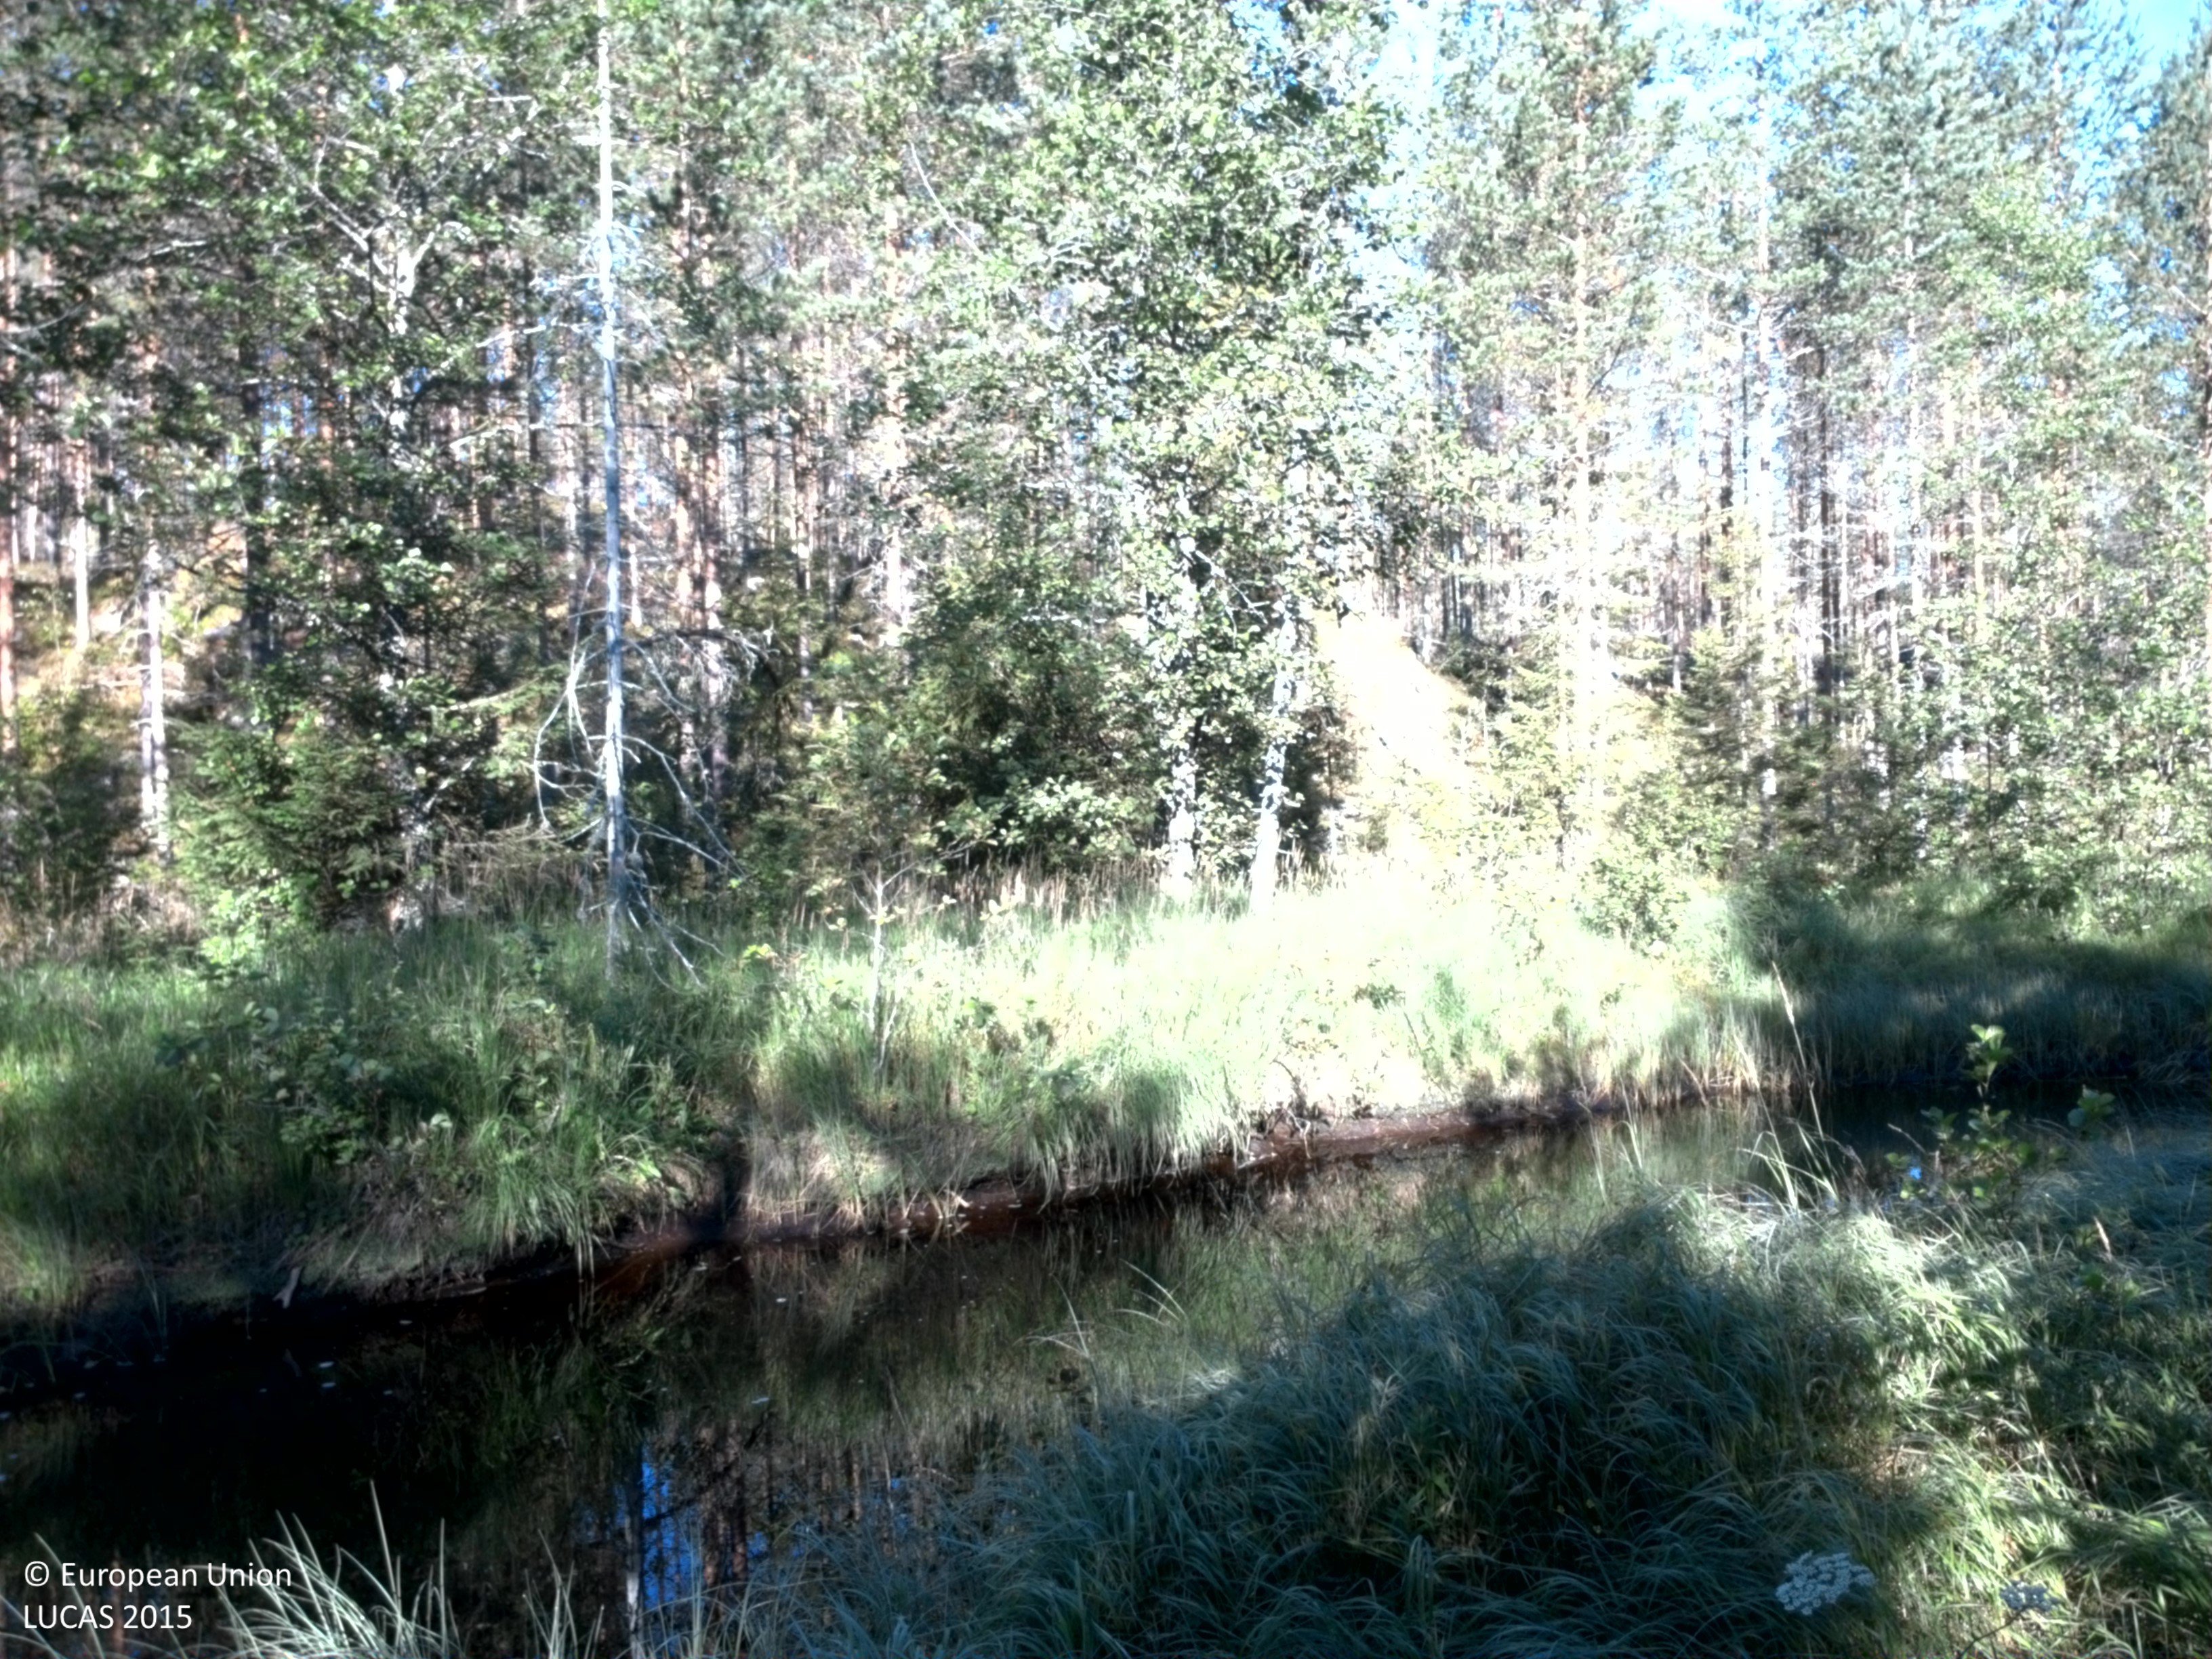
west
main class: Woodland
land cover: Broadleaved woodland
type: mire and swamp forests
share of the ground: 25 - 50 %
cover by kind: broadleaved forest trees 40 %, herbaceous plants 40 %, shrubs 10 %, coniferous forest trees 5 %, lichens and mosses 5 %
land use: Forestry
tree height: > 5 m
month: August
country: SE
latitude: 60.2117
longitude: 13.4011
